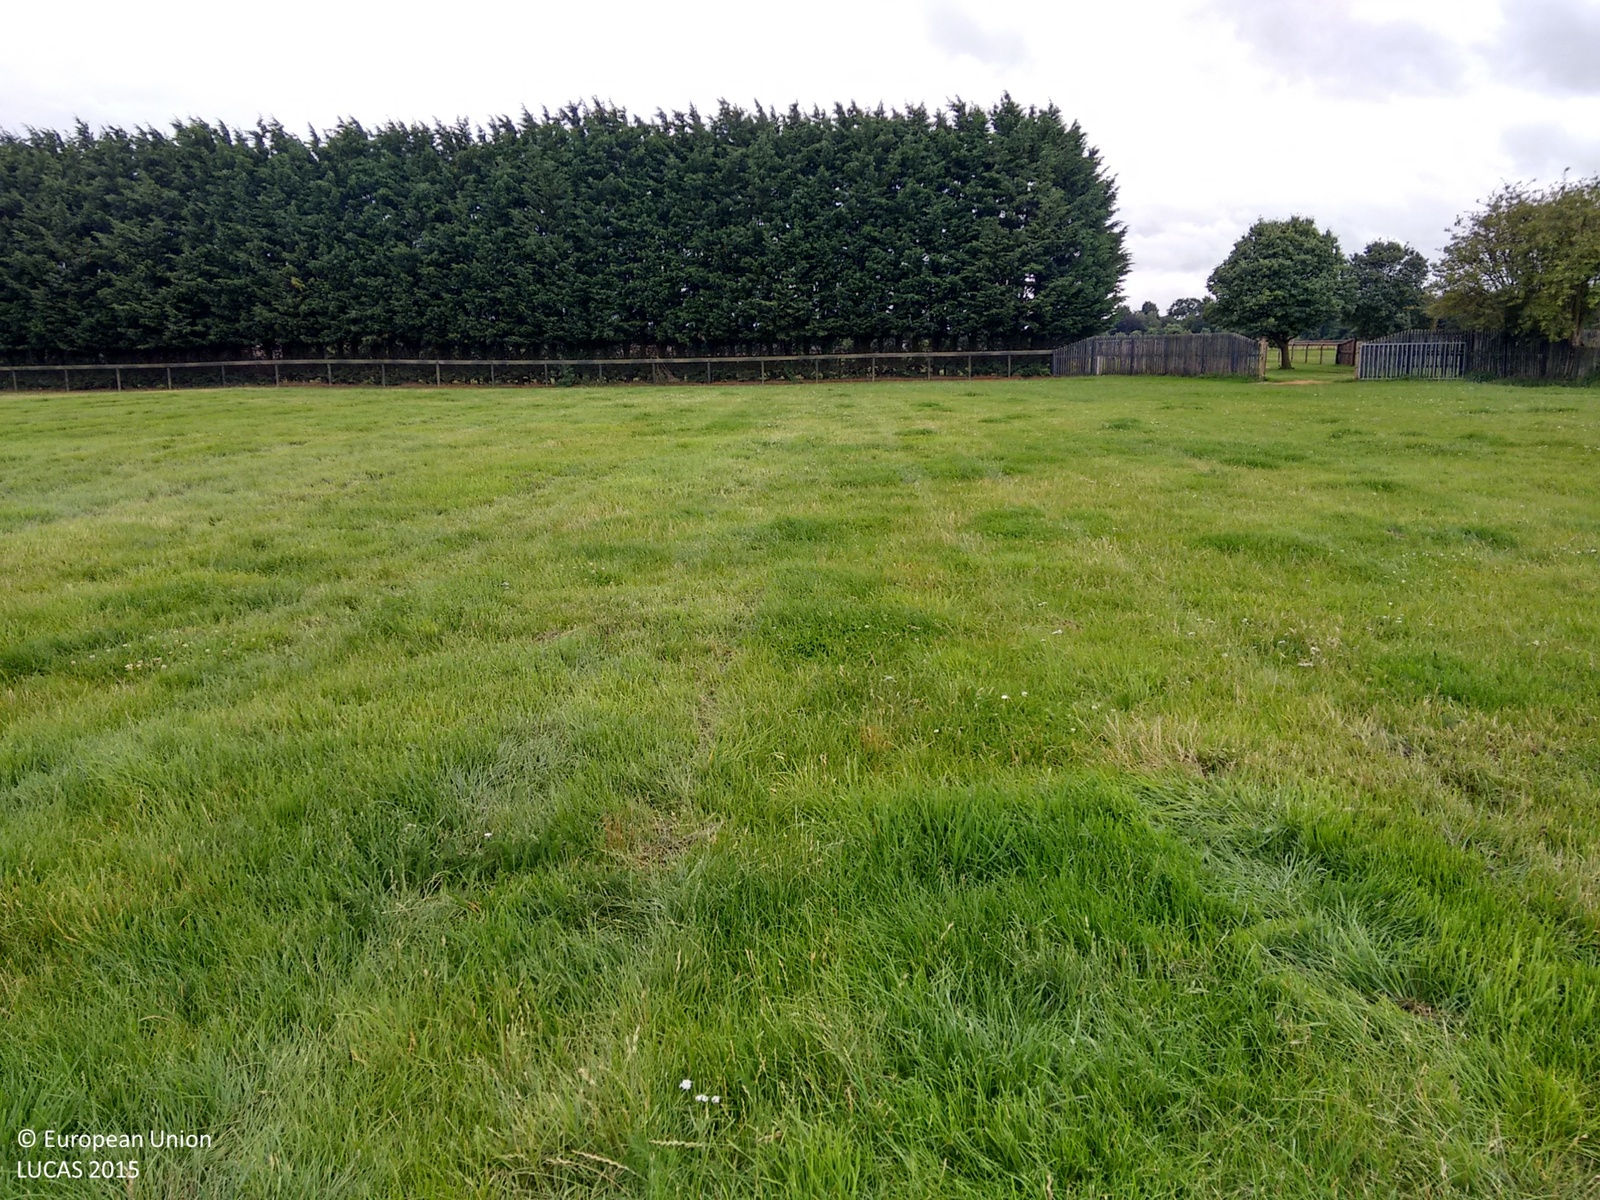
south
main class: Grassland
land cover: Grassland without tree/shrub cover
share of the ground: > 75 %
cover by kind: herbaceous plants 100 %
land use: Agriculture (excluding fallow land and kitchen gardens)
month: August
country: GB
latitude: 52.3247
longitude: 0.5384
